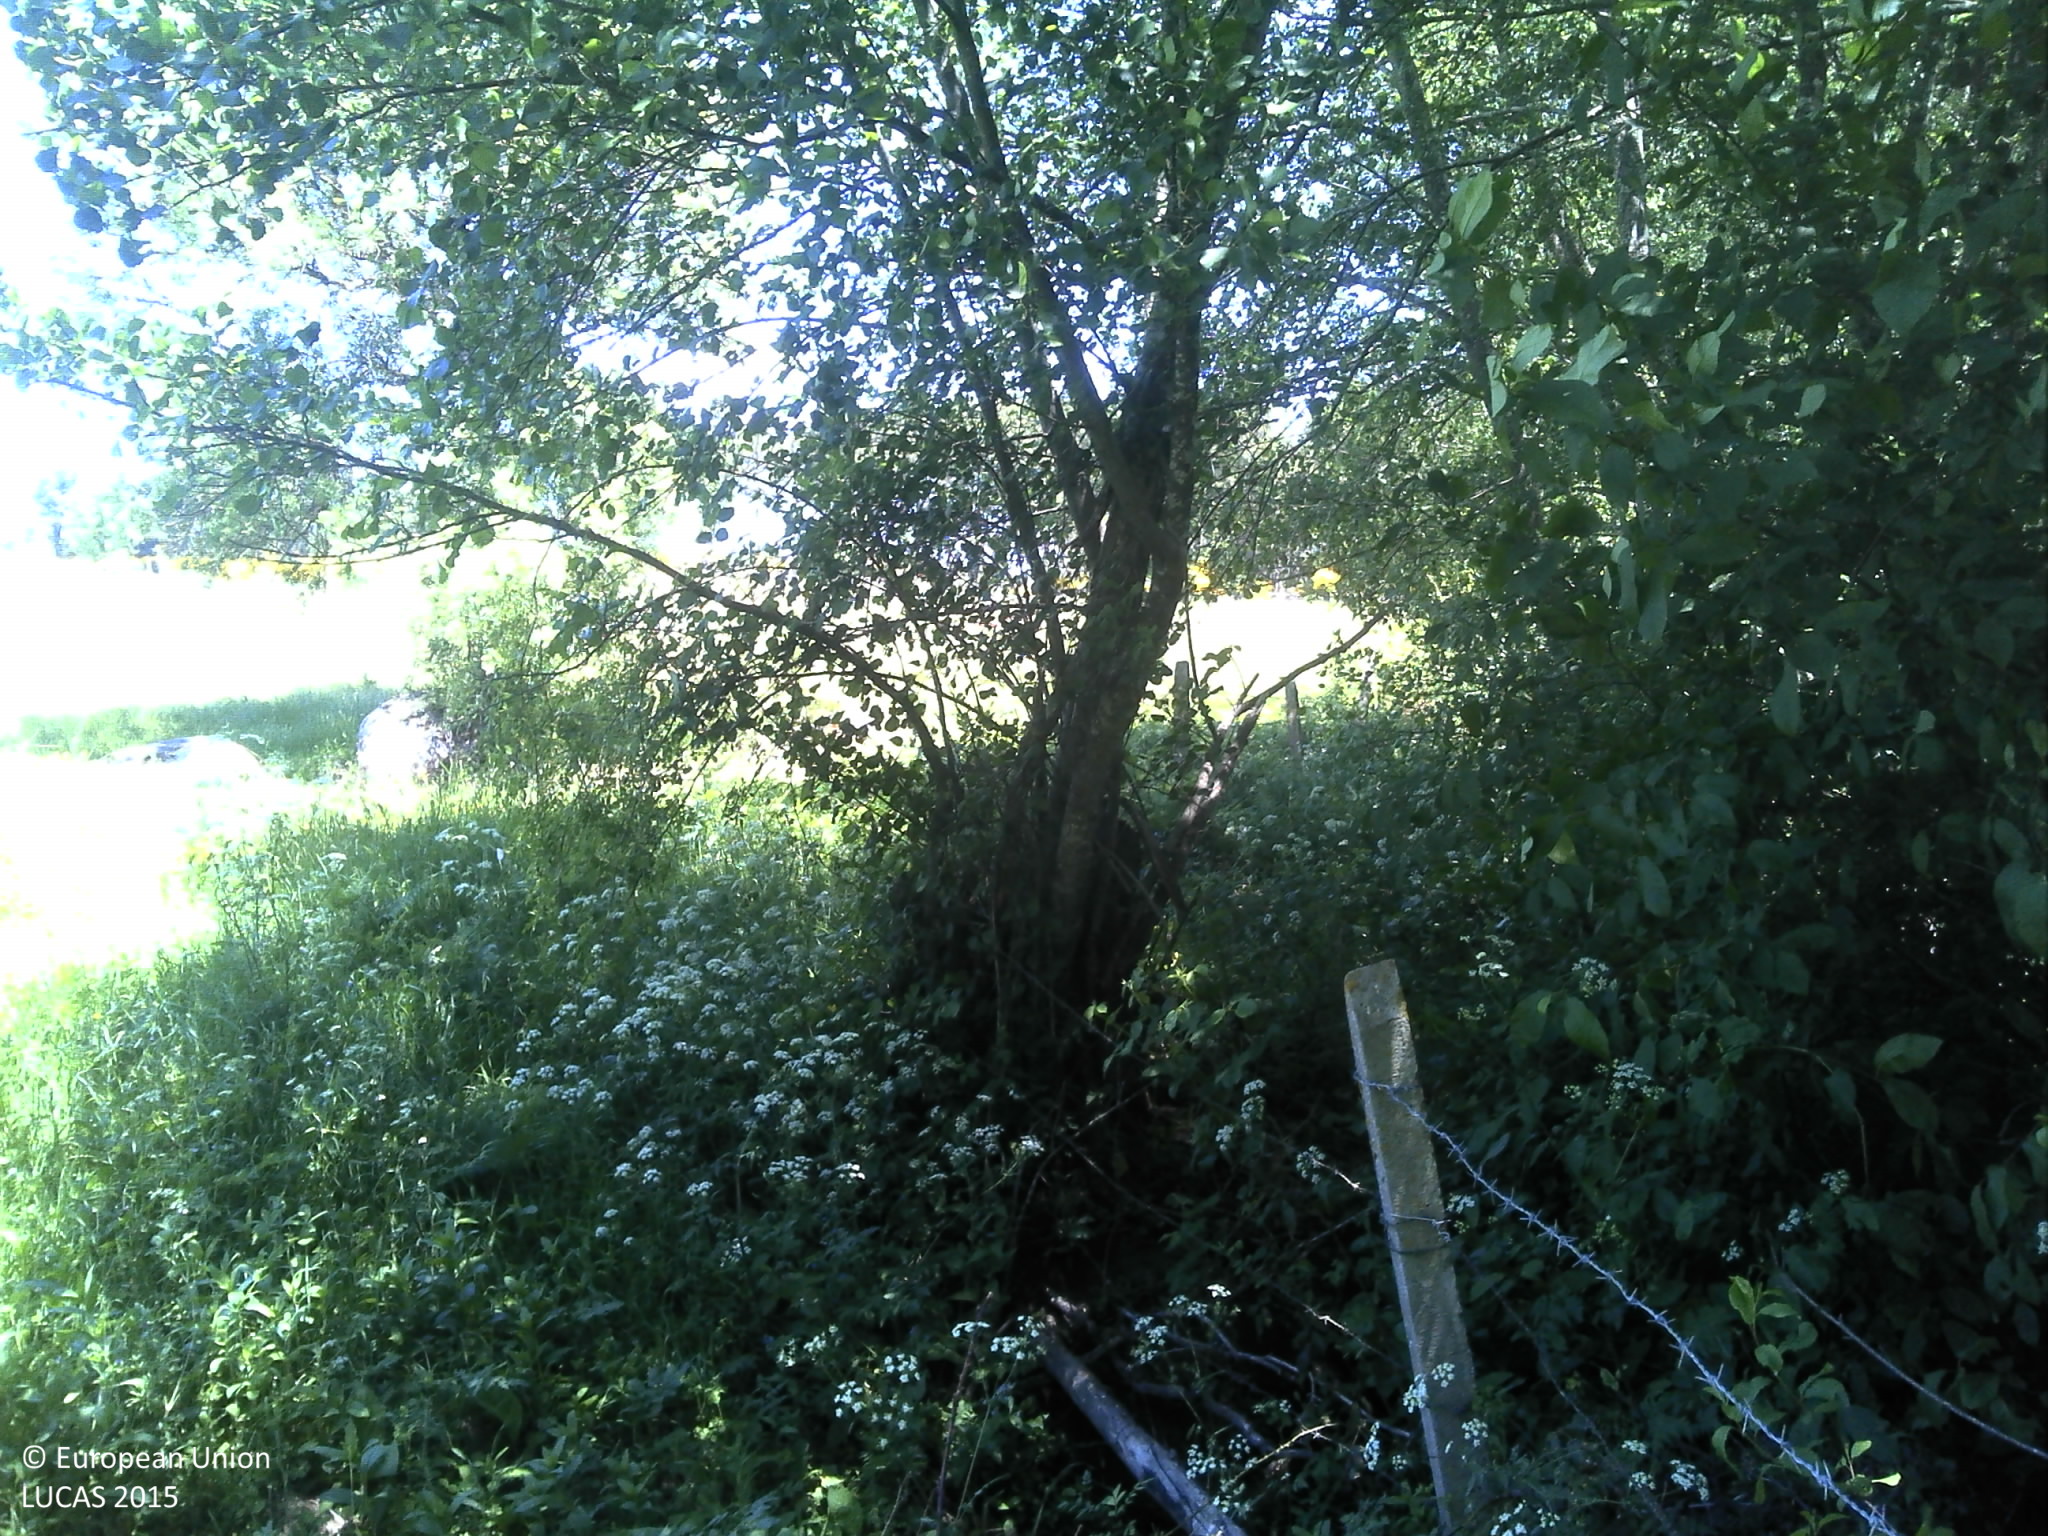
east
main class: Grassland
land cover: Grassland without tree/shrub cover
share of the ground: 50 - 75 %
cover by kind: herbaceous plants 65 %, consolidated bare surface 15 %, unconsolidated bare surface 15 %
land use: Agriculture (excluding fallow land and kitchen gardens)
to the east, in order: Grassland without tree/shrub cover; Fences; Shruby margins; Rivers and streams; Shruby margins; Grassland without tree/shrub cover; Tracks; Grassland without tree/shrub cover; Abandoned hedges; Grassland without tree/shrub cover; Fences; Shrubland without tree cover; Tracks
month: May
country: PT
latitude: 40.5149
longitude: -7.2540
